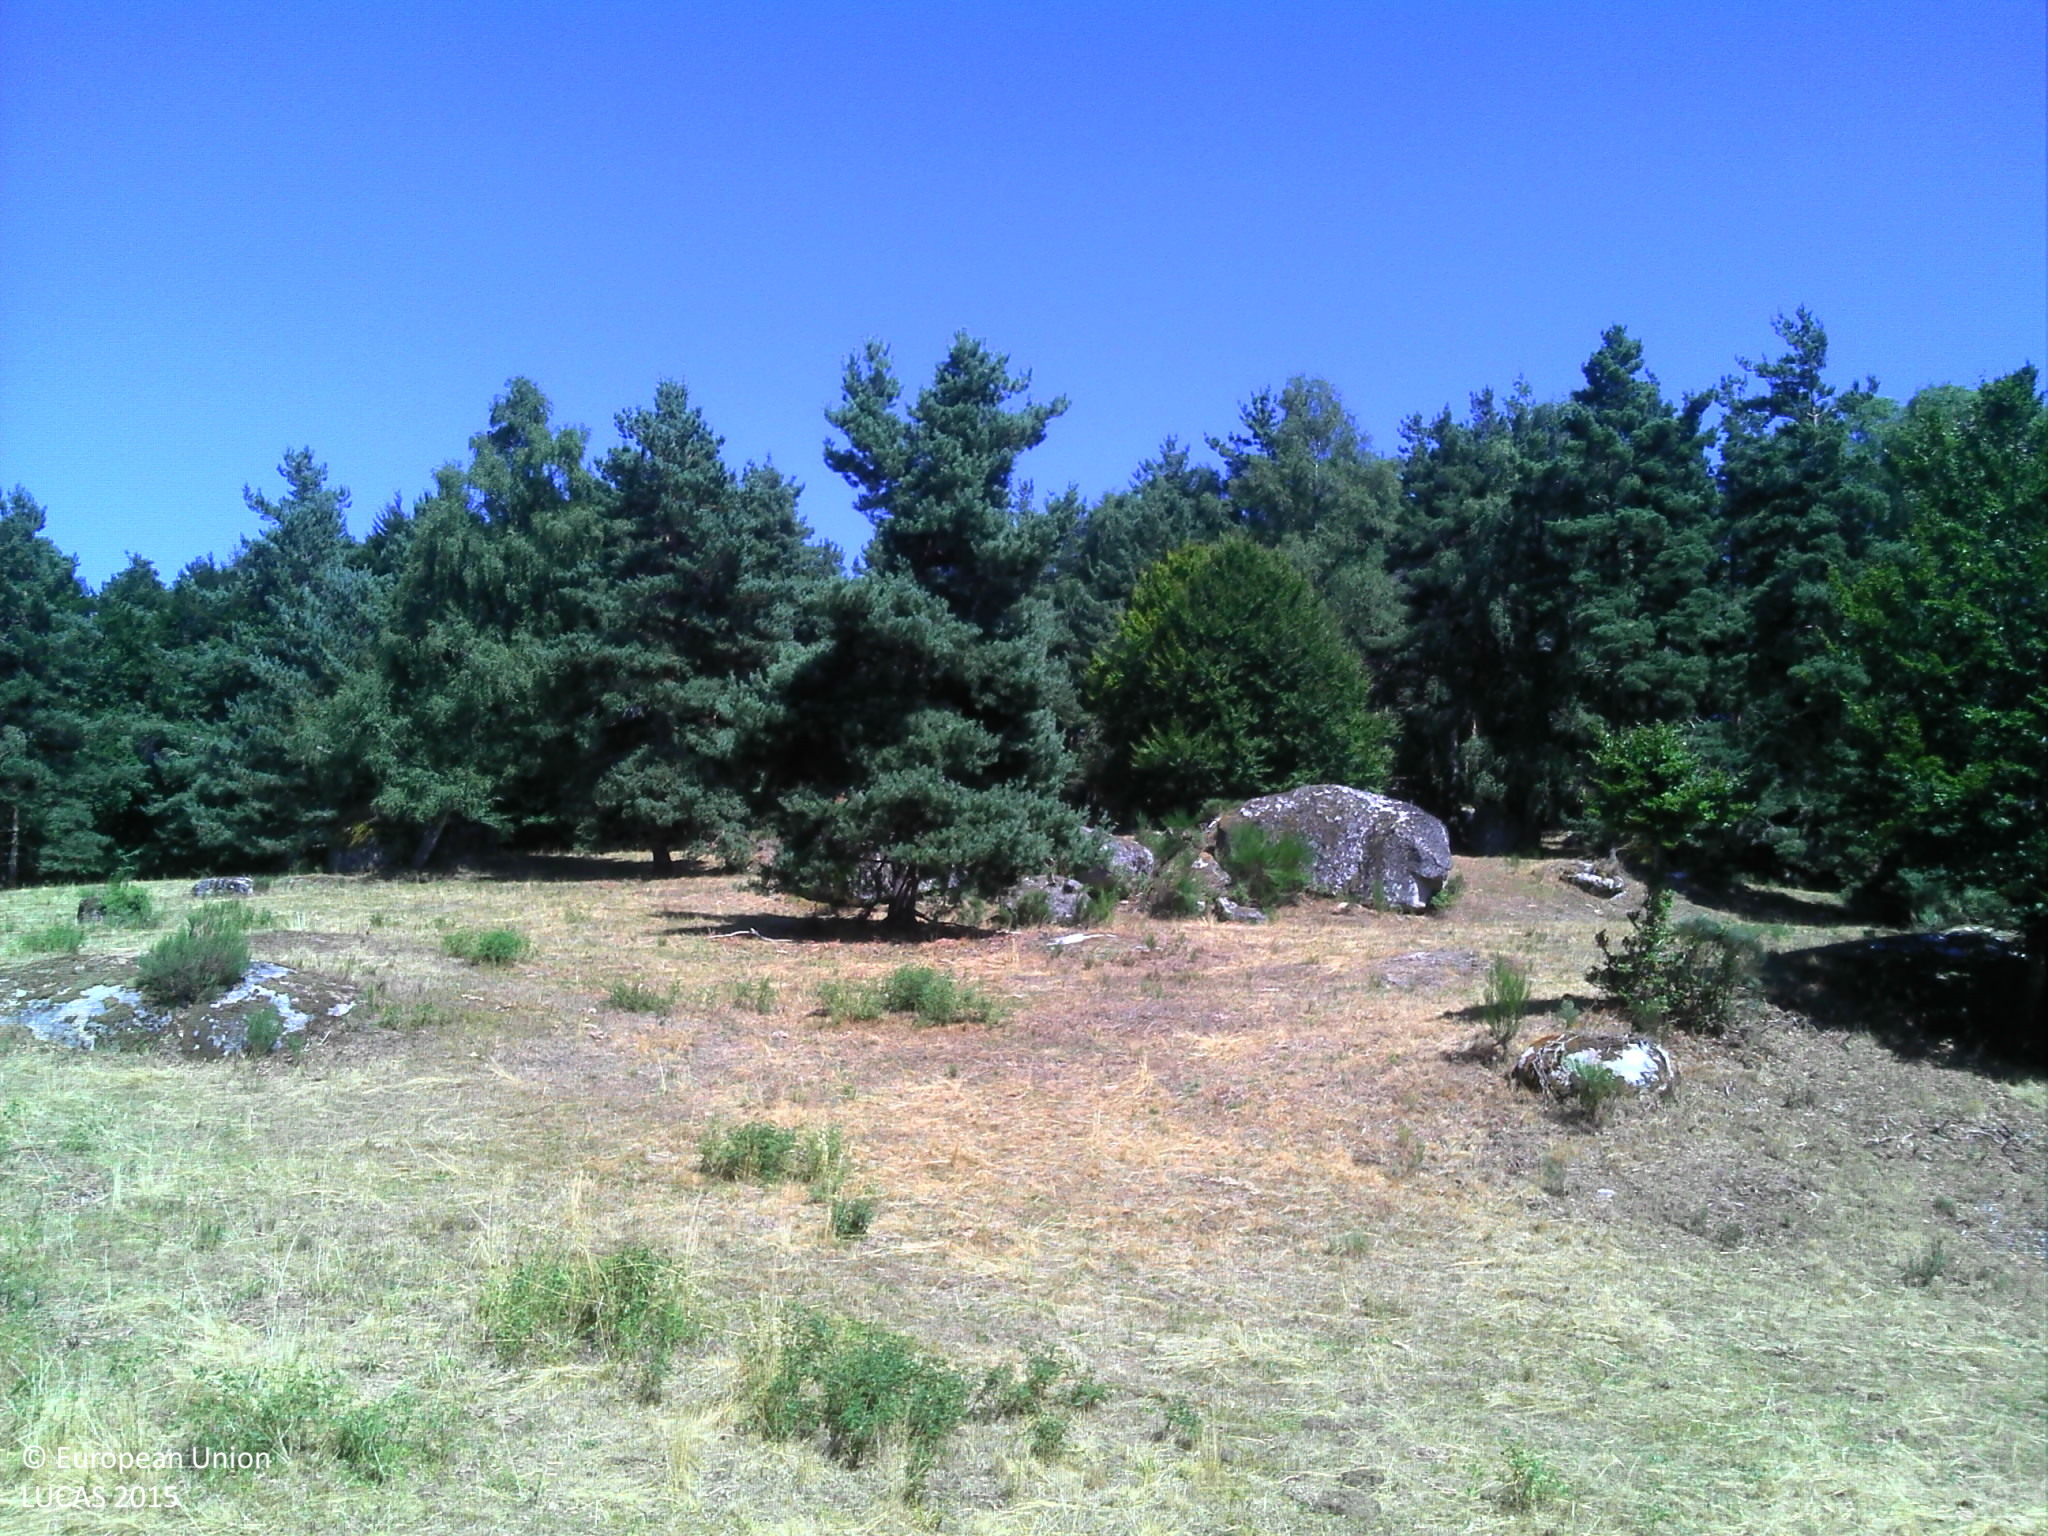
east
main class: Grassland
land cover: Grassland without tree/shrub cover
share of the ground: > 75 %
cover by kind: herbaceous plants 95 %, shrubs 5 %
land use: Agriculture (excluding fallow land and kitchen gardens)
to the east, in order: Grassland without tree/shrub cover; Grassland with sparse tree/shrub cover; Broadleaved woodland; Grassland without tree/shrub cover; Broadleaved woodland
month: July
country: FR
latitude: 44.7045
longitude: 3.4540
